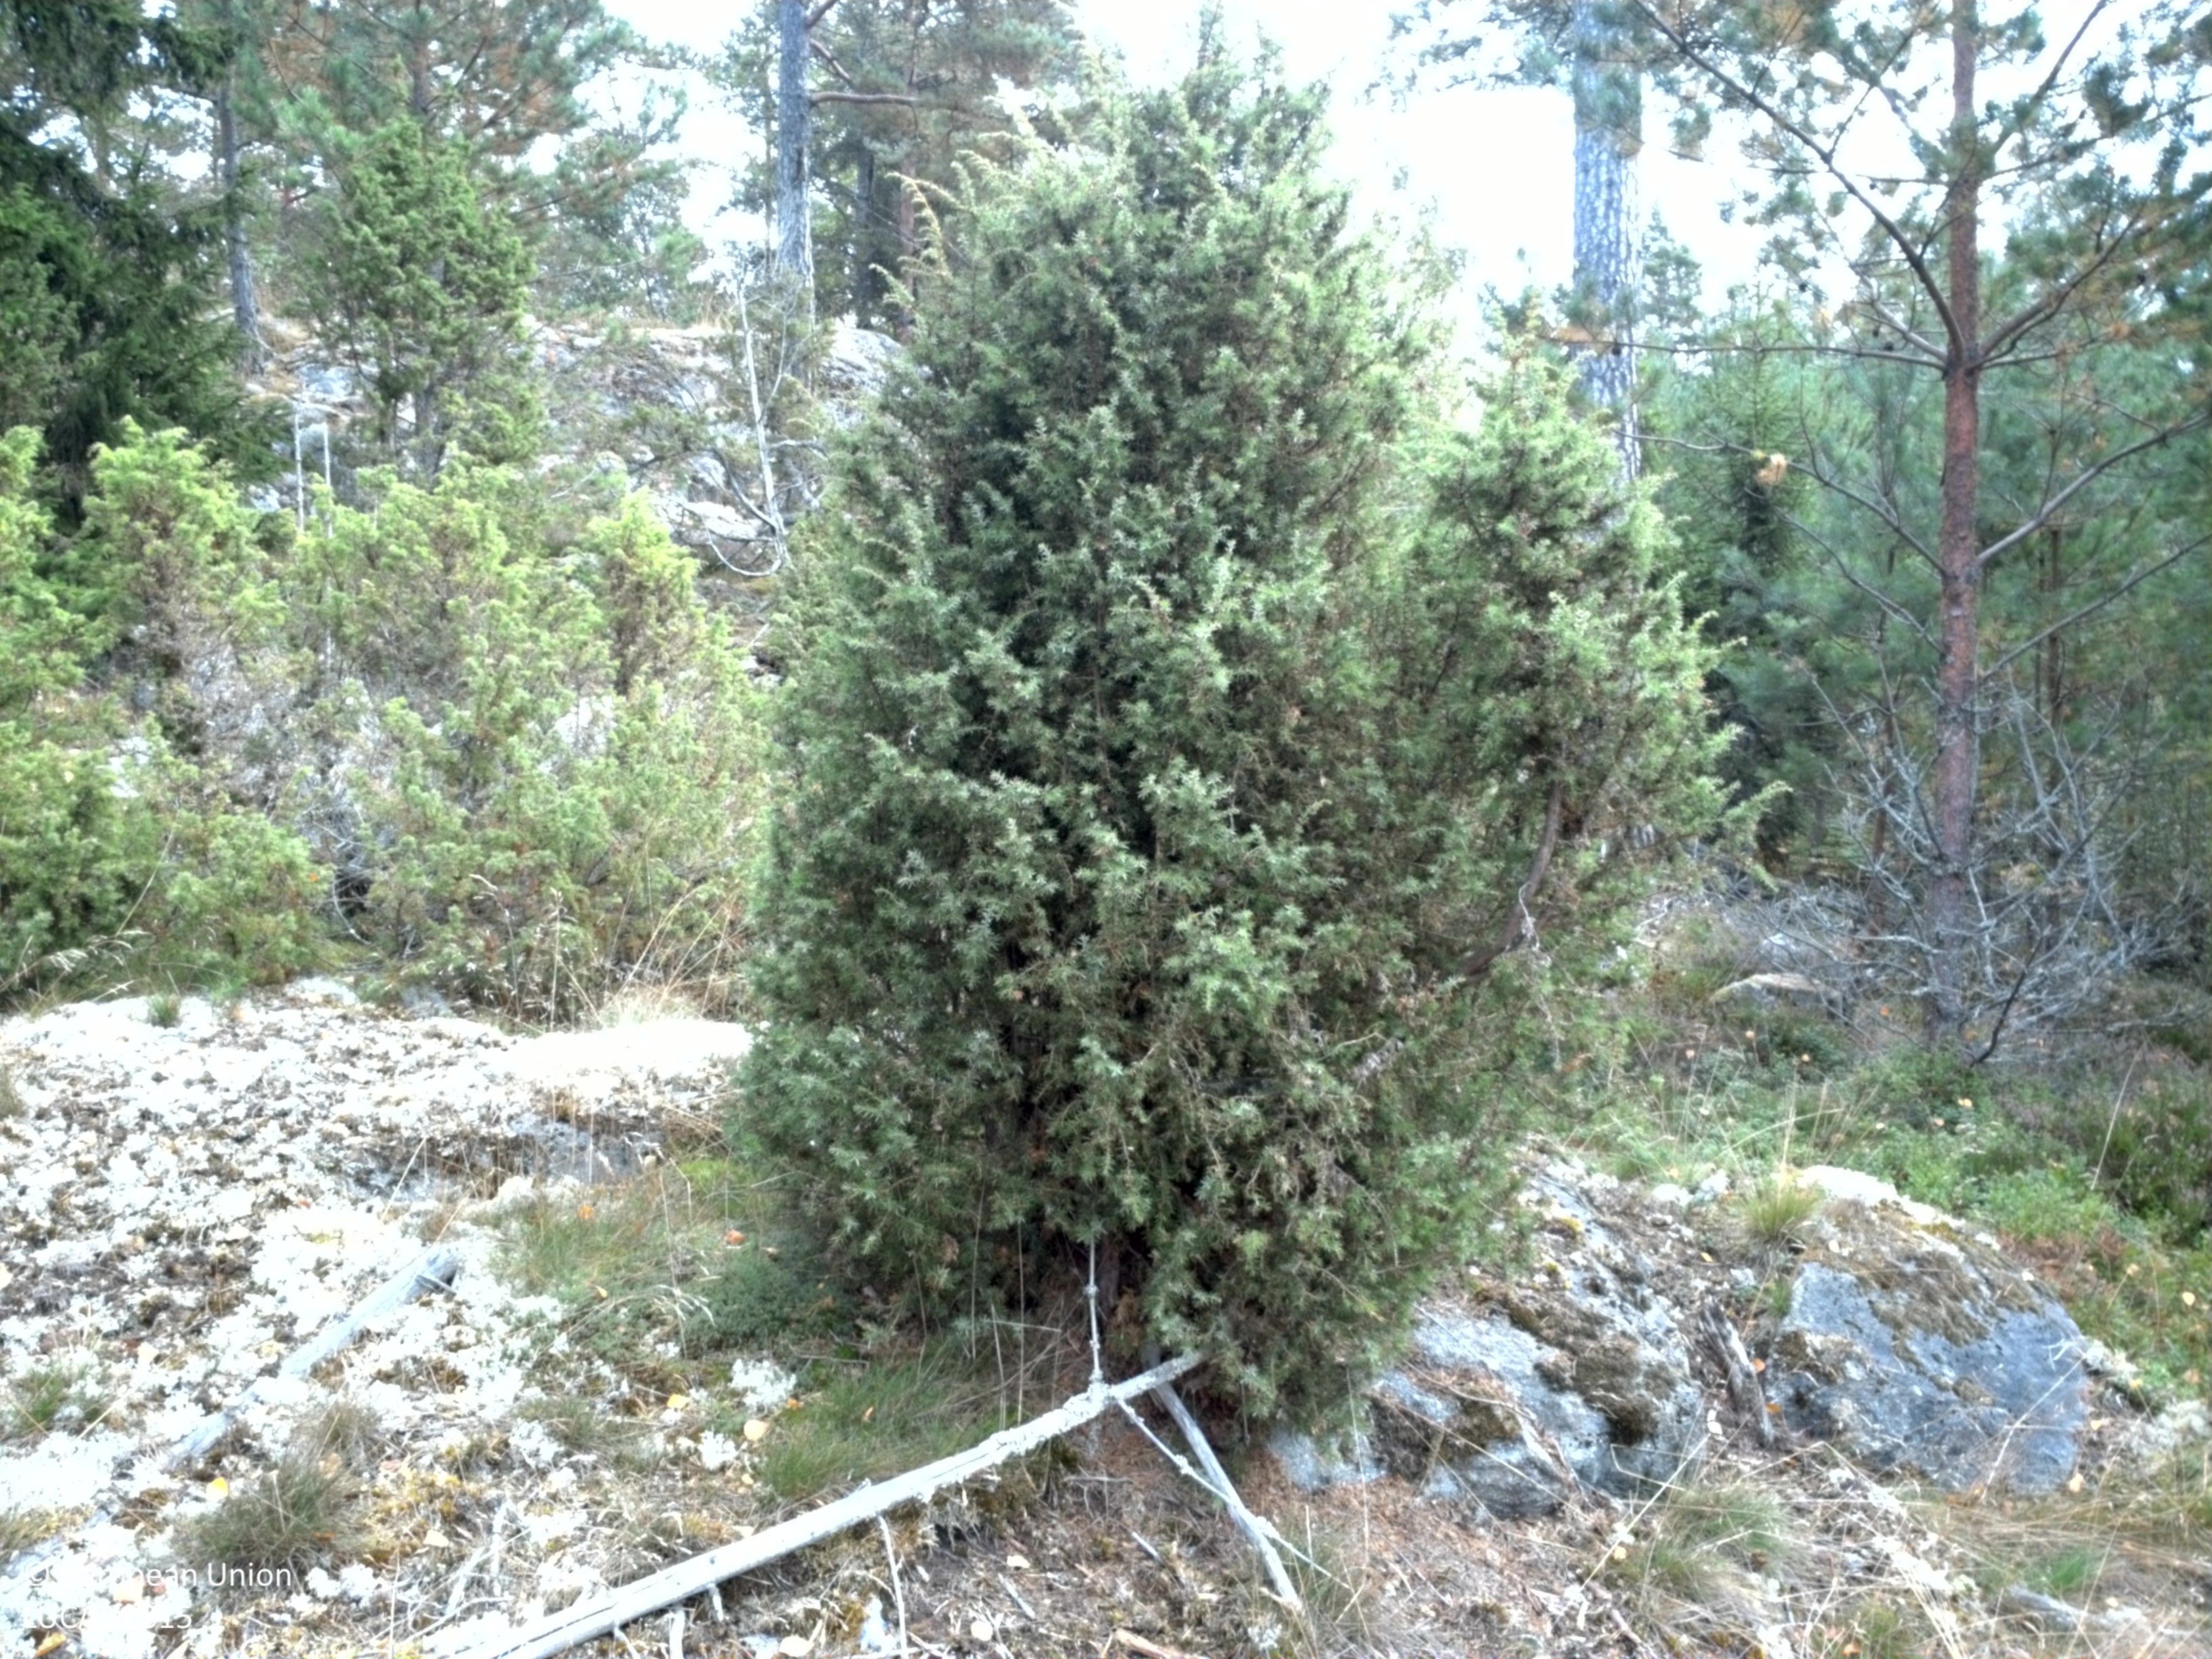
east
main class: Woodland
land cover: Spruce dominated mixed woodland
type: boreal forest
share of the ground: 25 - 50 %
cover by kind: coniferous forest trees 30 %, lichens and mosses 30 %, herbaceous plants 25 %, broadleaved forest trees 10 %, consolidated bare surface 5 %
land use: Forestry
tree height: > 5 m
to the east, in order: Spruce dominated mixed woodland; Other coniferous woodland; Pine dominated mixed woodland; Broadleaved woodland; Pine dominated mixed woodland; Broadleaved woodland; Spruce dominated mixed woodland
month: September
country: SE
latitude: 59.2533
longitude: 18.5065
